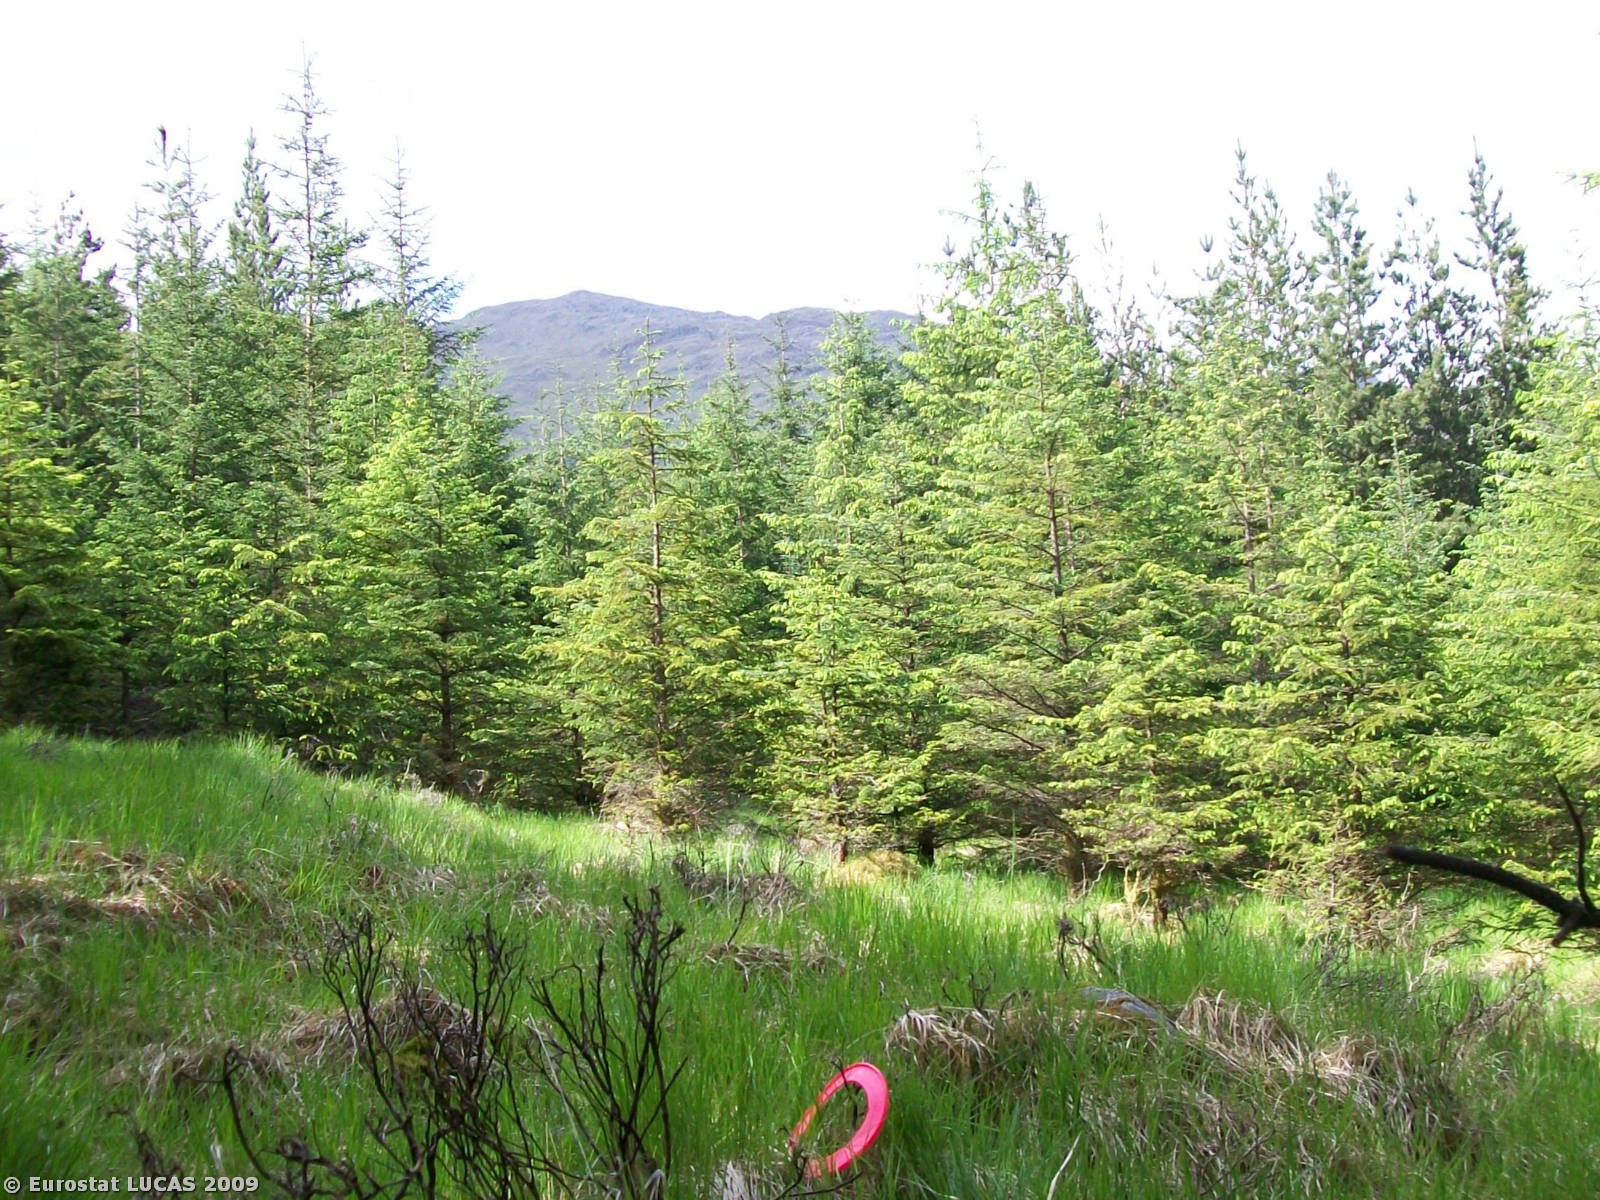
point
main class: Shrubland
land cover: Shrubland without tree cover
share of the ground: 25 - 50 %
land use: Forestry
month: May
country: GB
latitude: 56.8974
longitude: -5.4341
